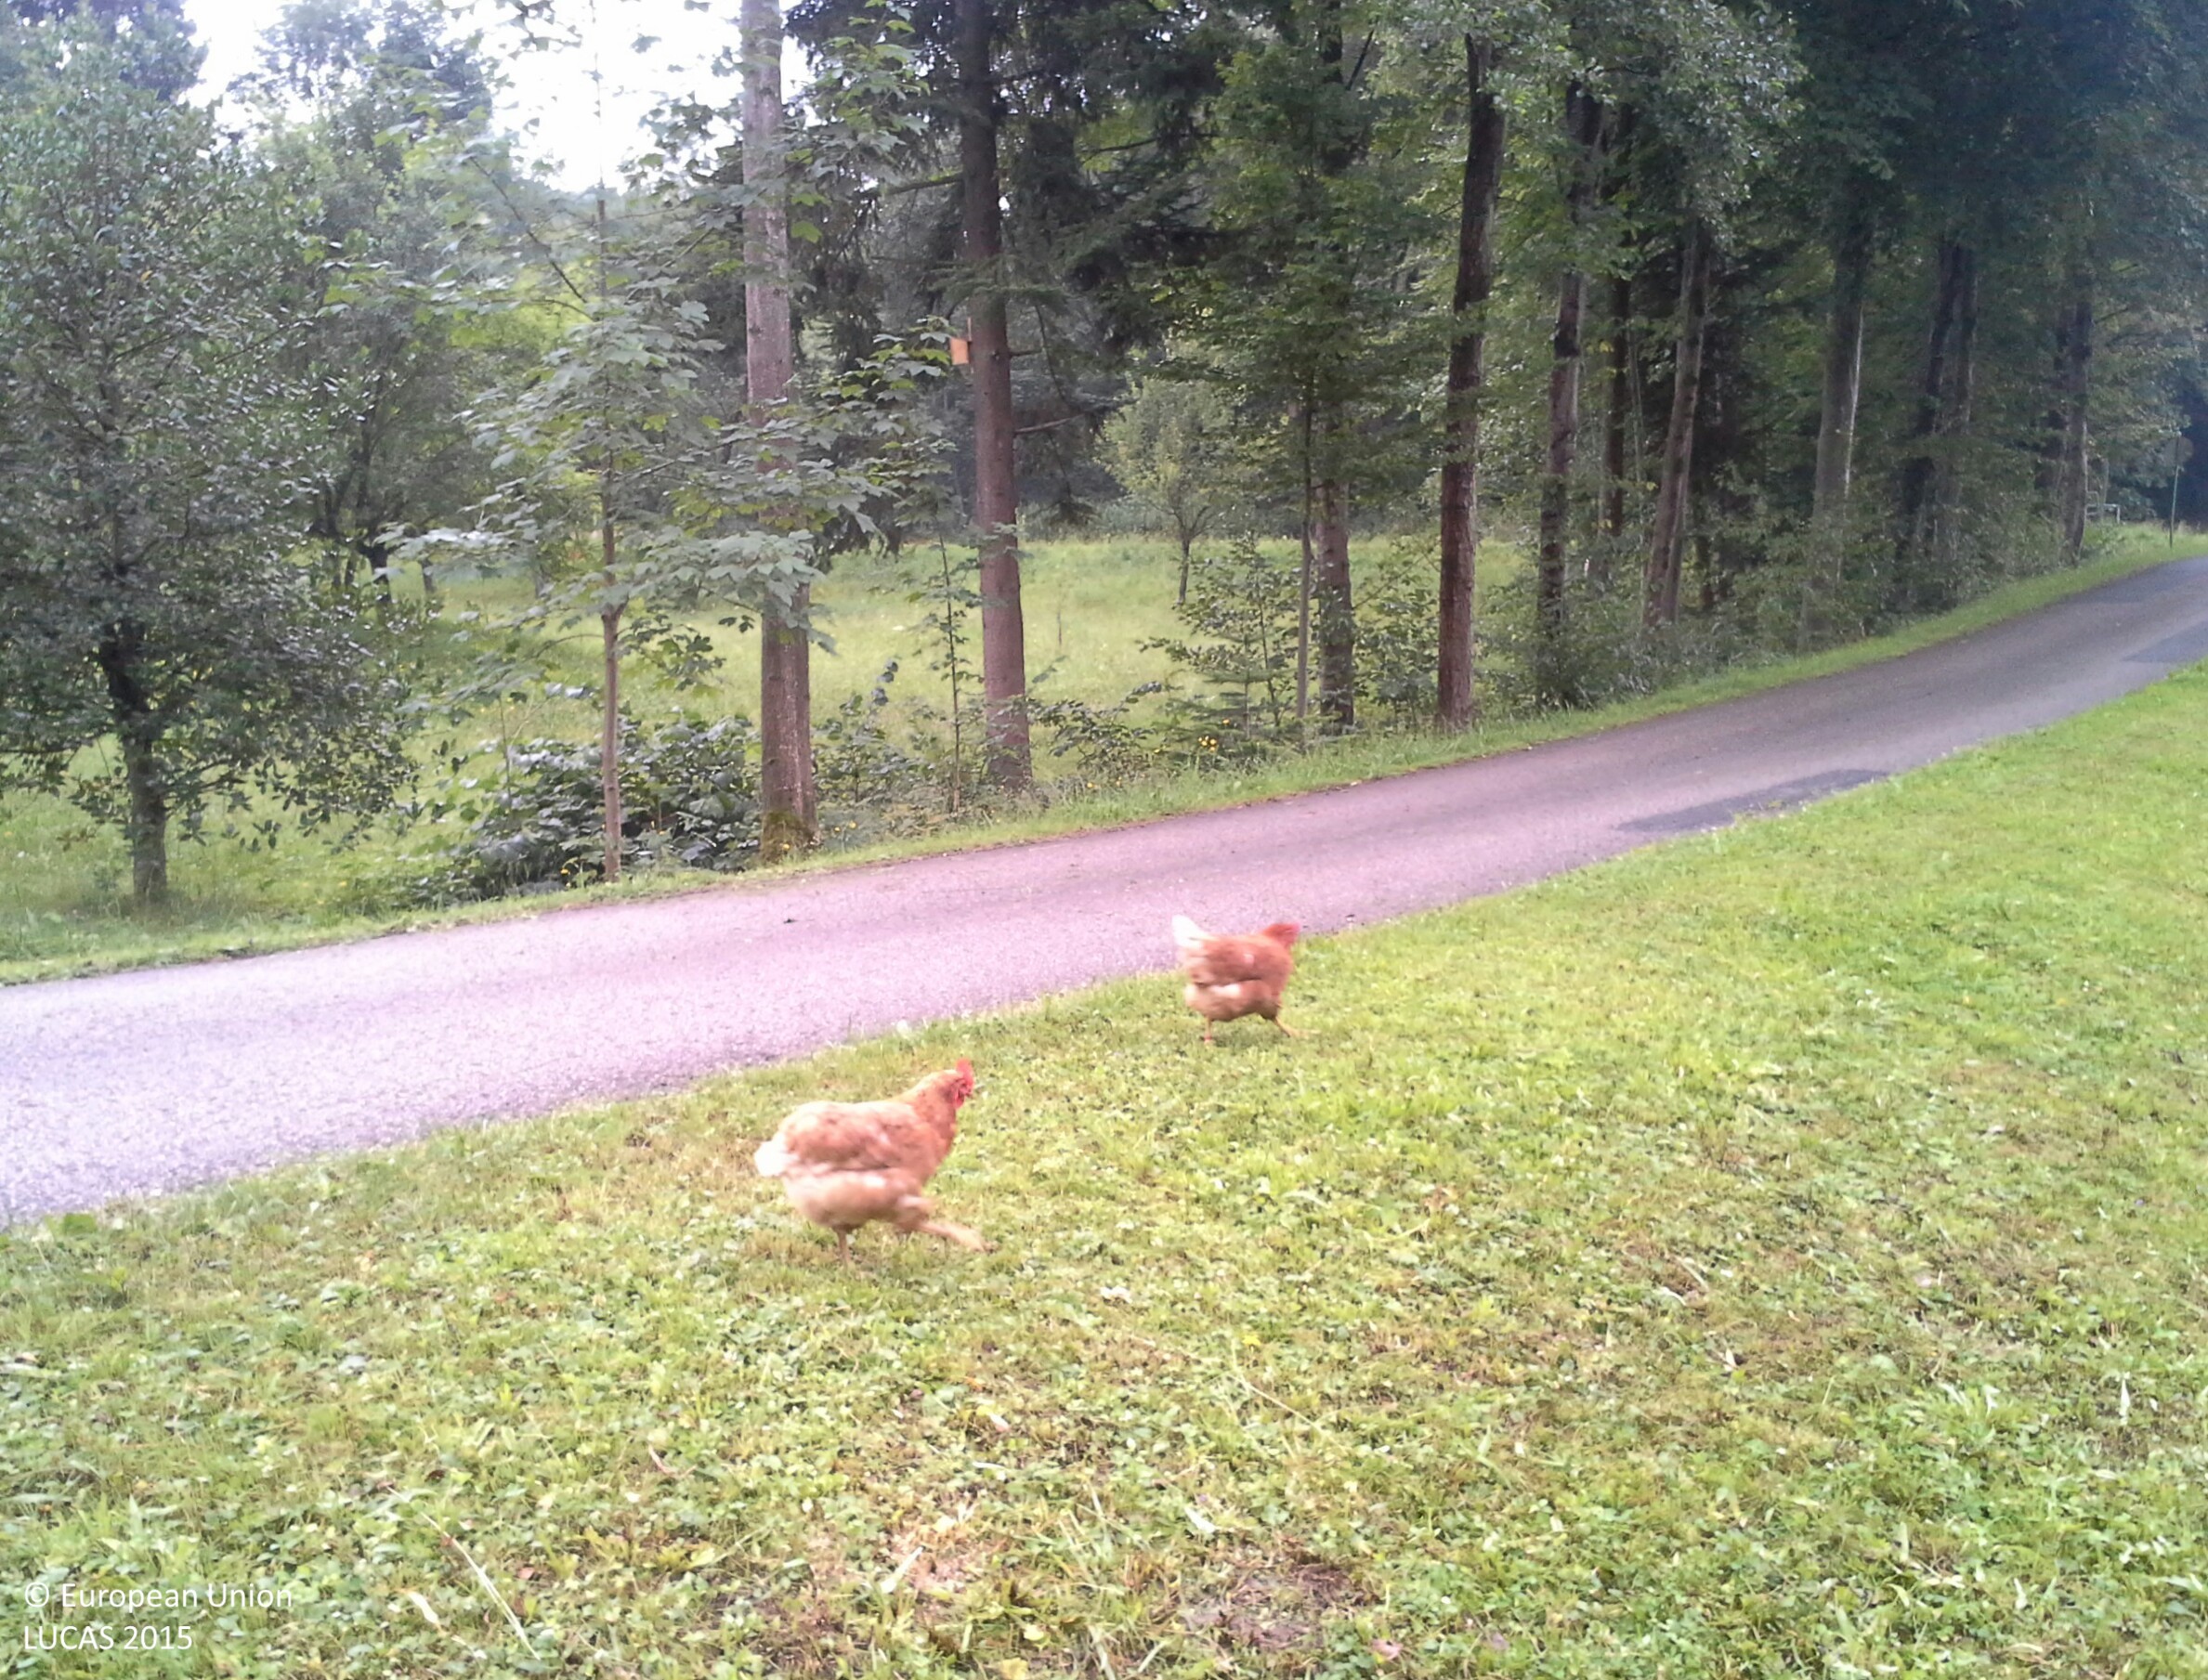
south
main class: Grassland
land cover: Grassland without tree/shrub cover
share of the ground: > 75 %
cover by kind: herbaceous plants 100 %
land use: Agriculture (excluding fallow land and kitchen gardens)
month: July
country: AT
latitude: 48.0271
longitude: 14.8415
